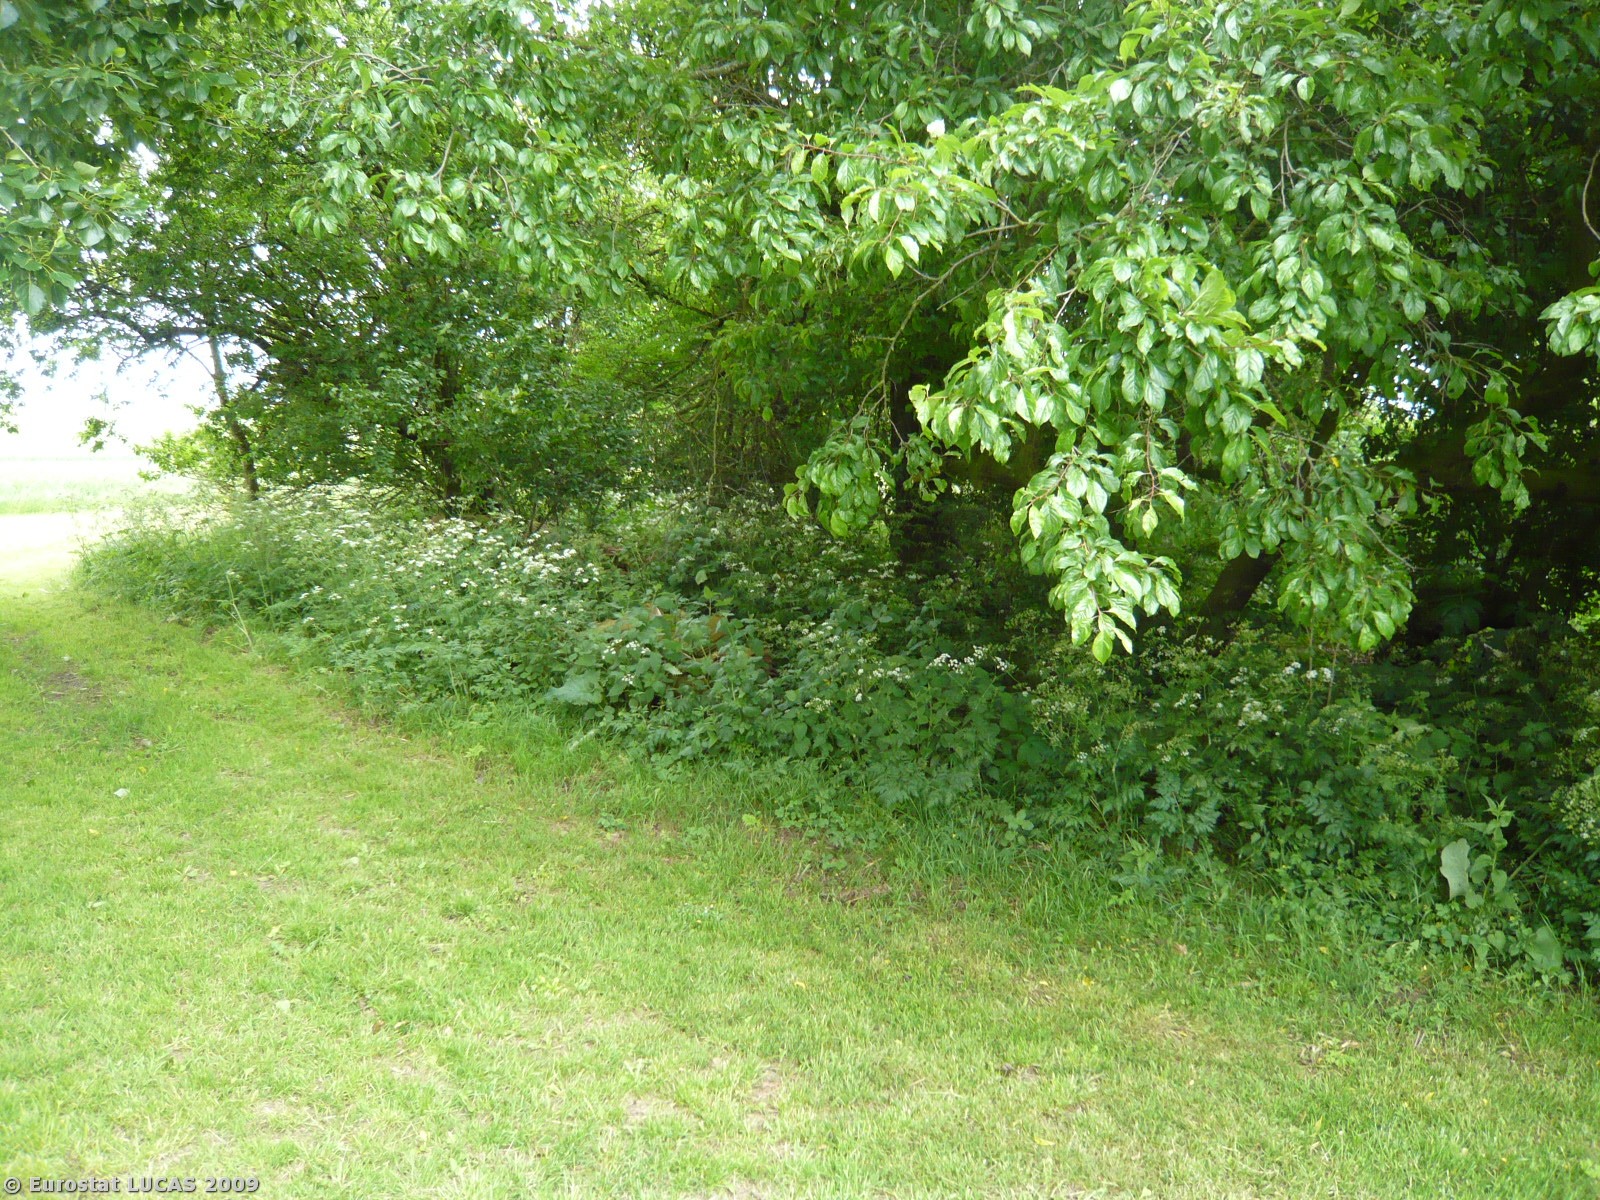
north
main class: Grassland
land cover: Grassland without tree/shrub cover
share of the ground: > 75 %
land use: Agriculture (excluding fallow land and kitchen gardens)
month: June
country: DK
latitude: 54.9323
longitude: 11.9496
